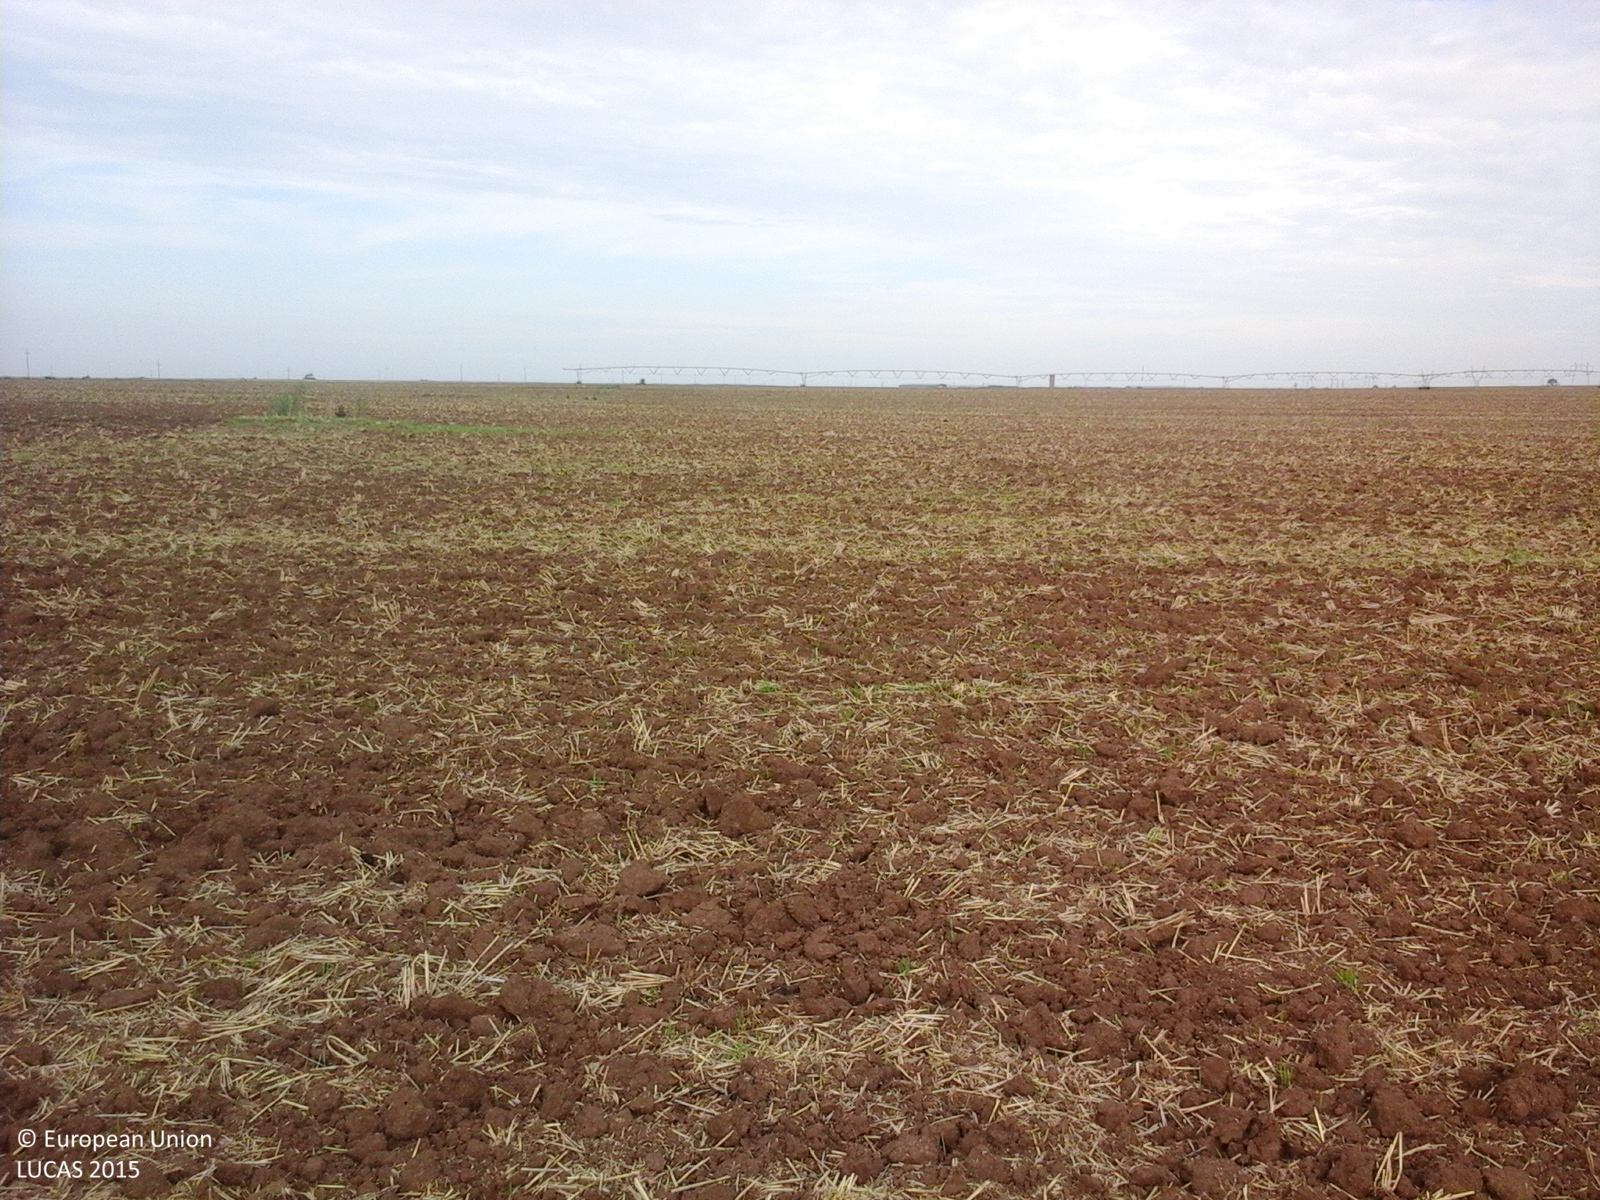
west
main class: Cropland
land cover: Common wheat
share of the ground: 10 - 25 %
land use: Agriculture (excluding fallow land and kitchen gardens)
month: August
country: RO
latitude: 46.1026
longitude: 21.4056
